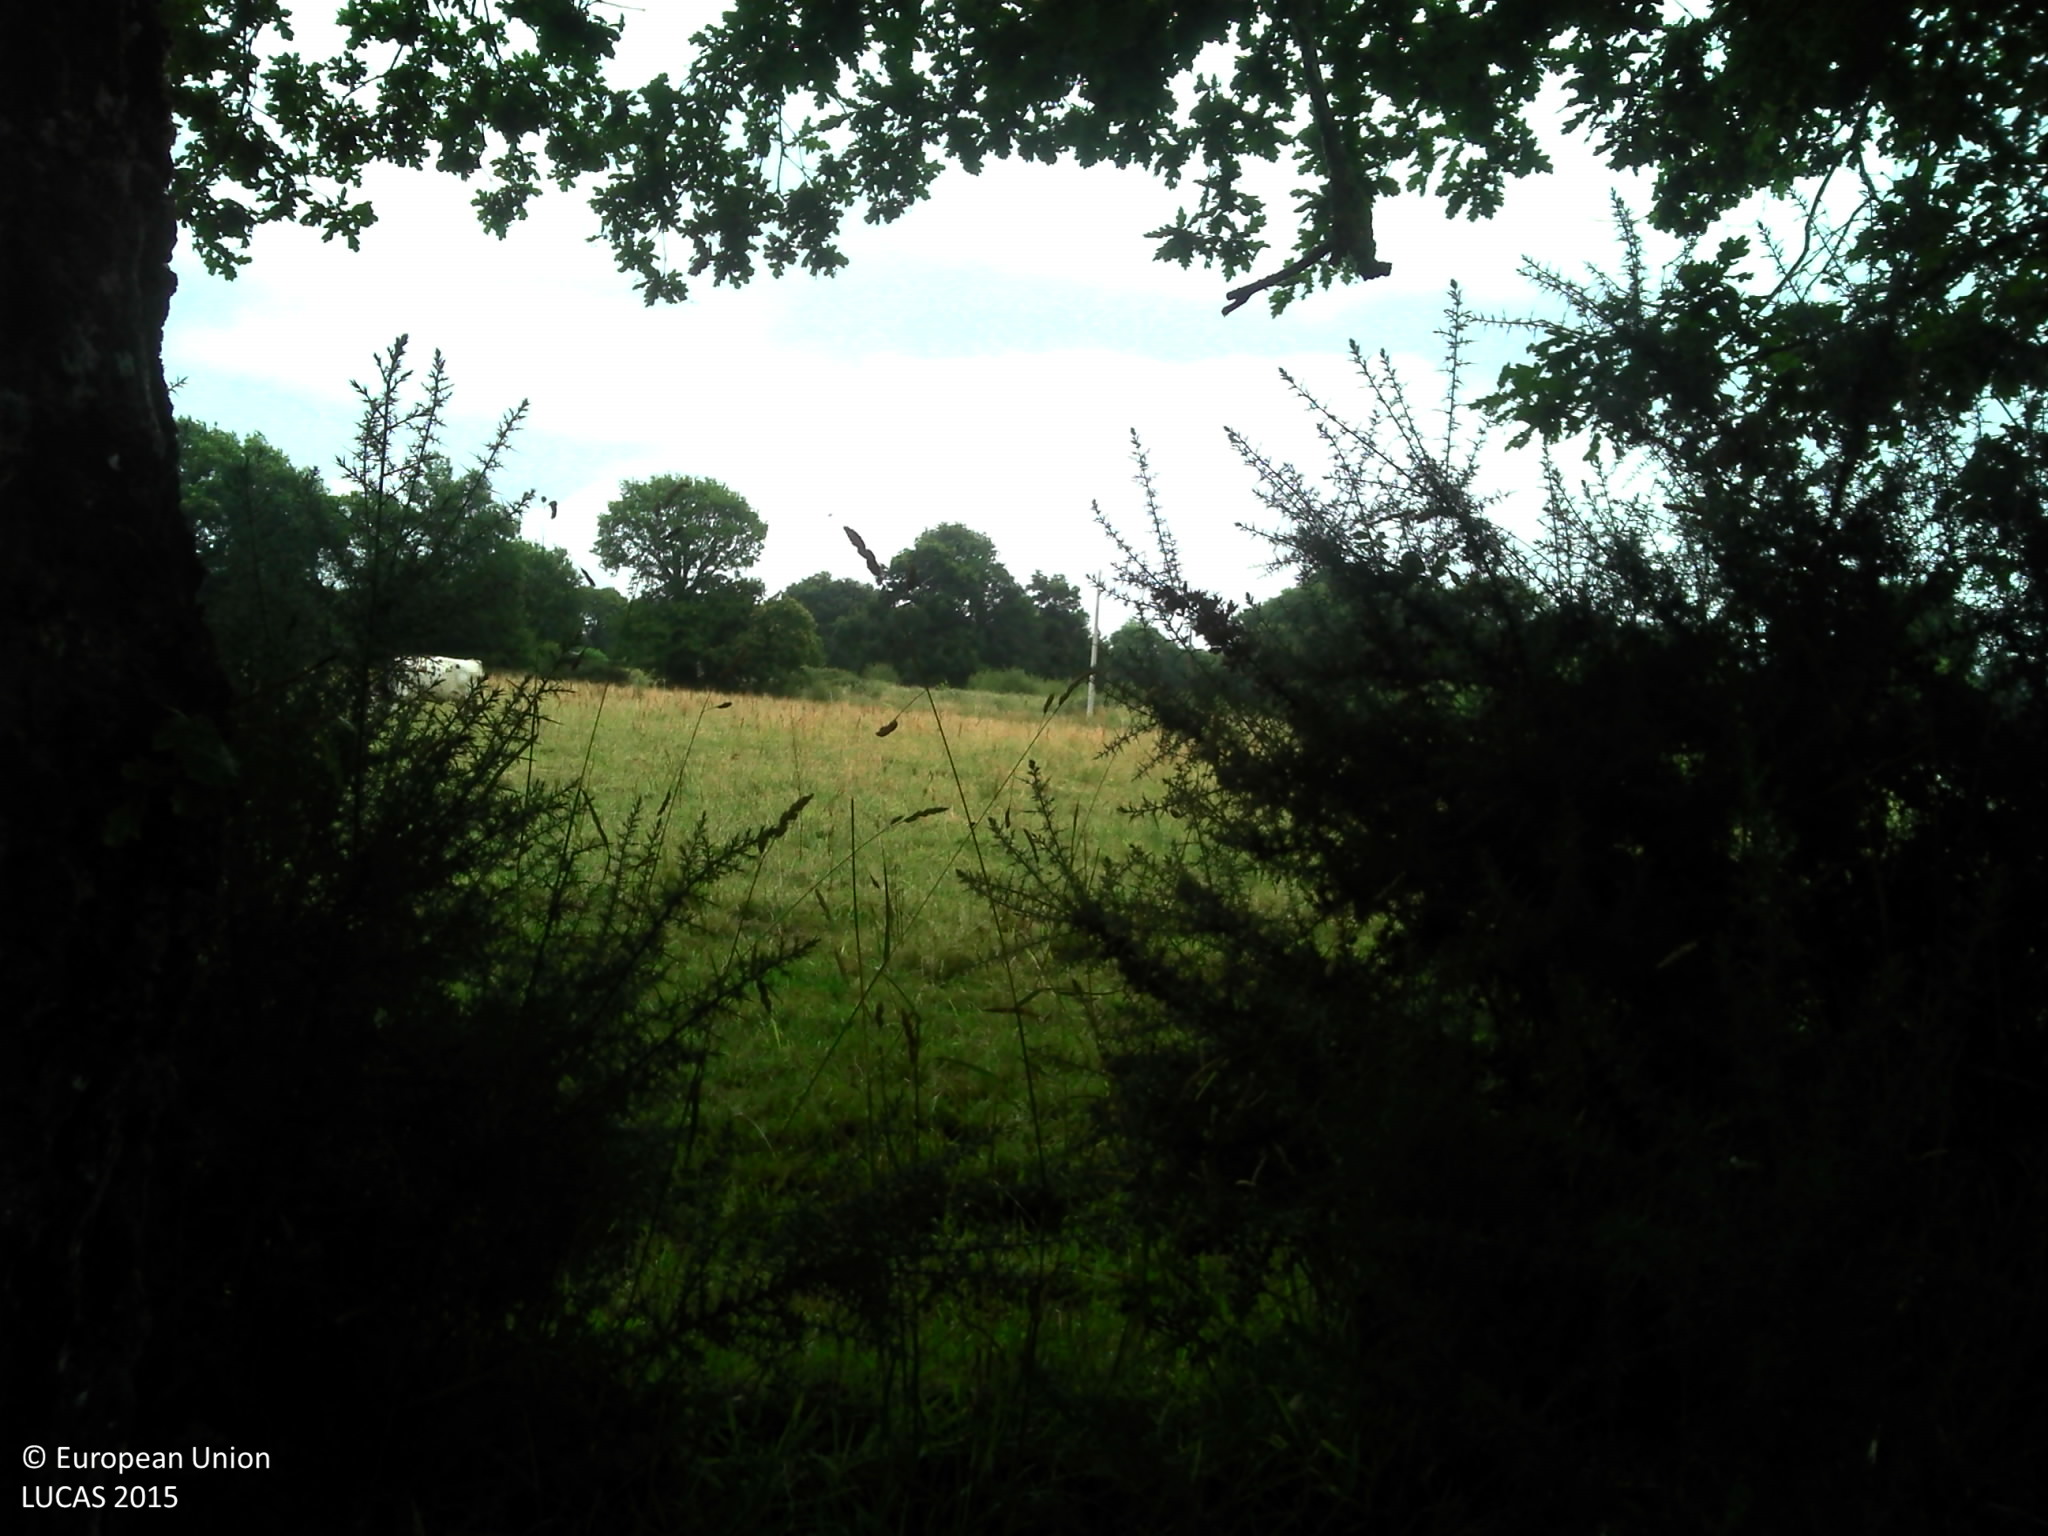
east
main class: Woodland
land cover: Broadleaved woodland
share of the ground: > 75 %
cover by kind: broadleaved forest trees 70 %, herbaceous plants 30 %
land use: Forestry
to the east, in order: Broadleaved woodland; Grassland without tree/shrub cover; Fences; Electric lines; Grass margins; Ditches and canals; Grass margins; Paved roads, cycling and walking lanes; Grass margins; Electric lines; Ditches and canals; Grassland without tree/shrub cover; Tracks; Fences; Lines of trees; Grassland without tree/shrub cover; Lines of trees; Fences; Grassland without tree/shrub cover
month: July
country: FR
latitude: 48.2742
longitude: -2.0047
